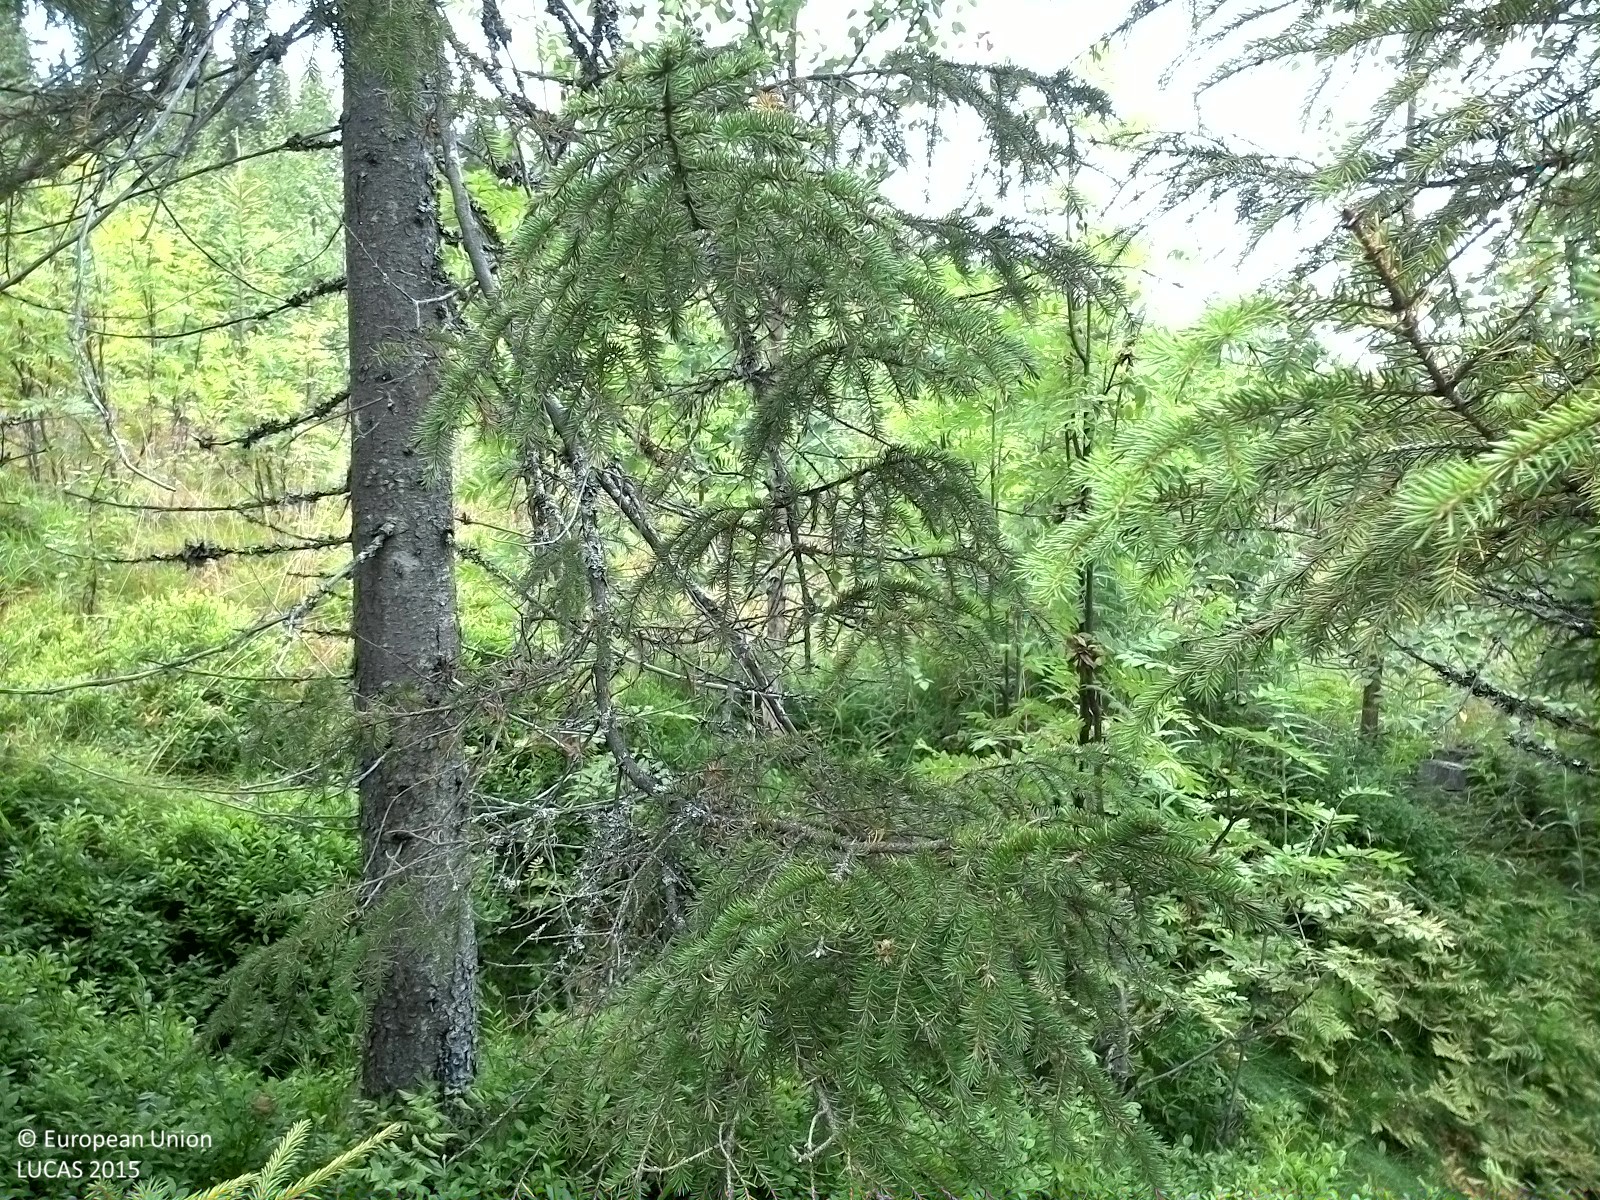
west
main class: Woodland
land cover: Spruce dominated mixed woodland
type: boreal forest
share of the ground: 25 - 50 %
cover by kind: herbaceous plants 30 %, coniferous forest trees 25 %, broadleaved forest trees 25 %, shrubs 20 %
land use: Forestry
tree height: > 5 m
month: August
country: SE
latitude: 62.2839
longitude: 16.2441
